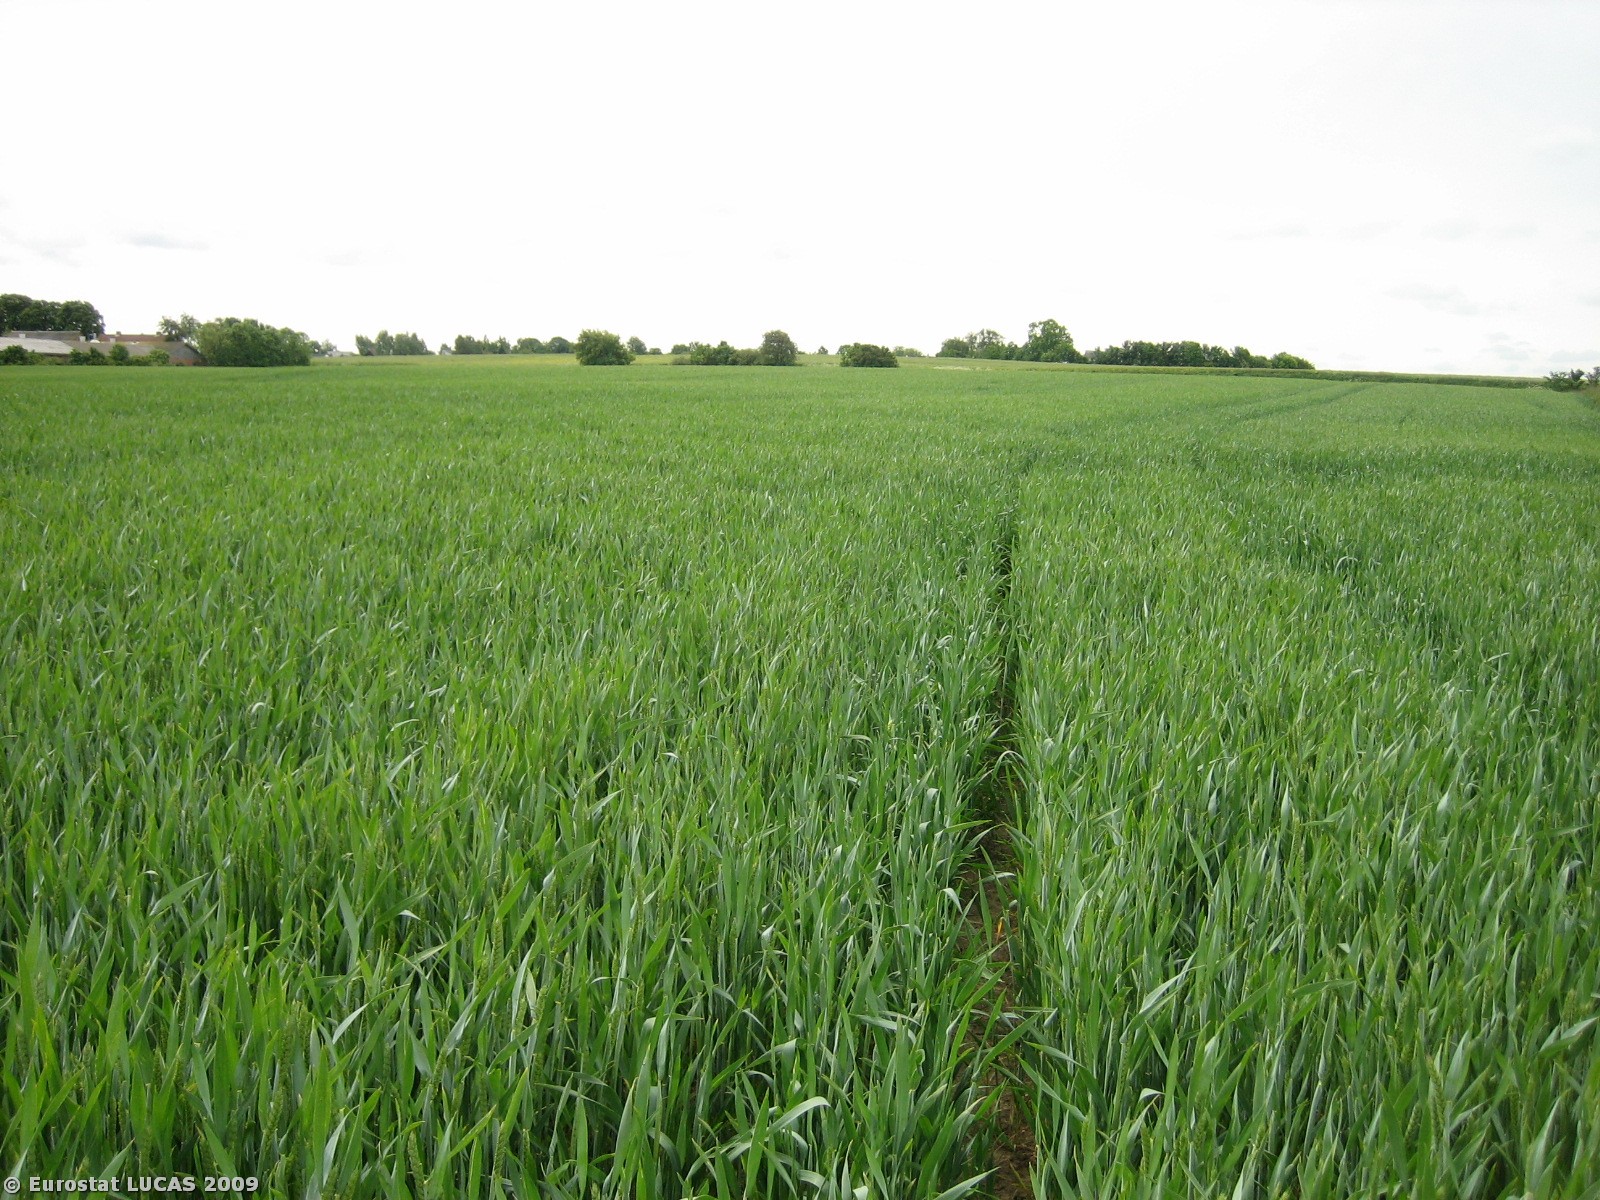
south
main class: Cropland
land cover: Common wheat
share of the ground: > 75 %
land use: Agriculture (excluding fallow land and kitchen gardens)
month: June
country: DK
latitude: 56.2596
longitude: 10.0161
